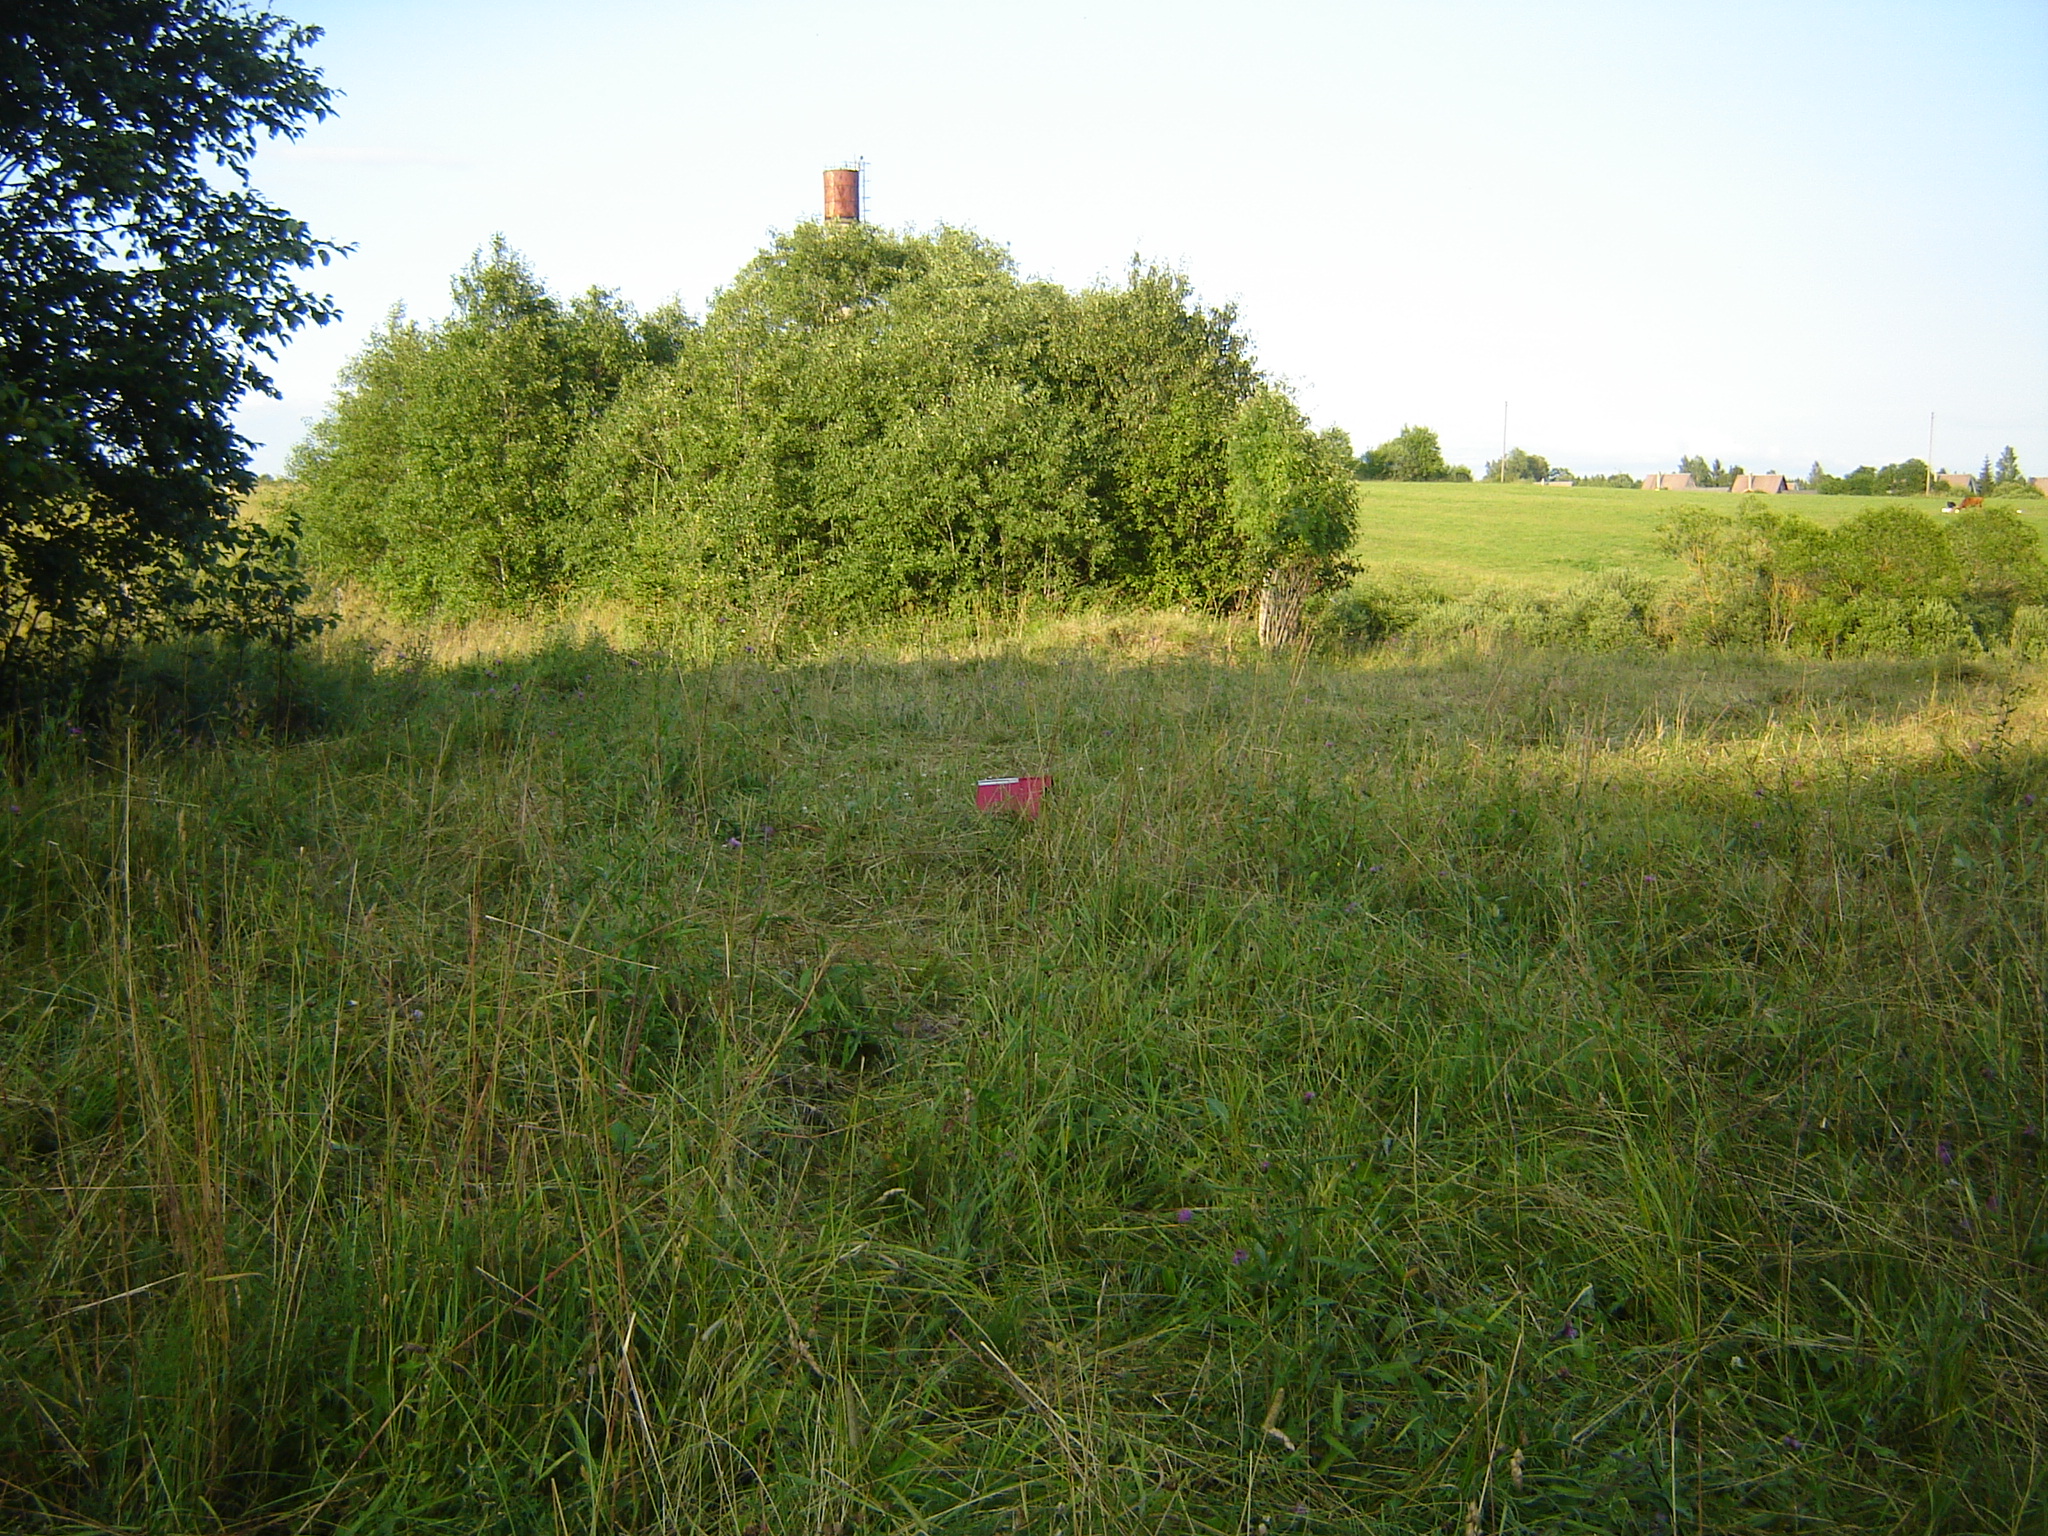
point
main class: Grassland
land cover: Grassland without tree/shrub cover
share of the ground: > 75 %
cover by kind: herbaceous plants 100 %
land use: Agriculture (excluding fallow land and kitchen gardens)
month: July
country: LT
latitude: 55.3901
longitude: 25.4524
